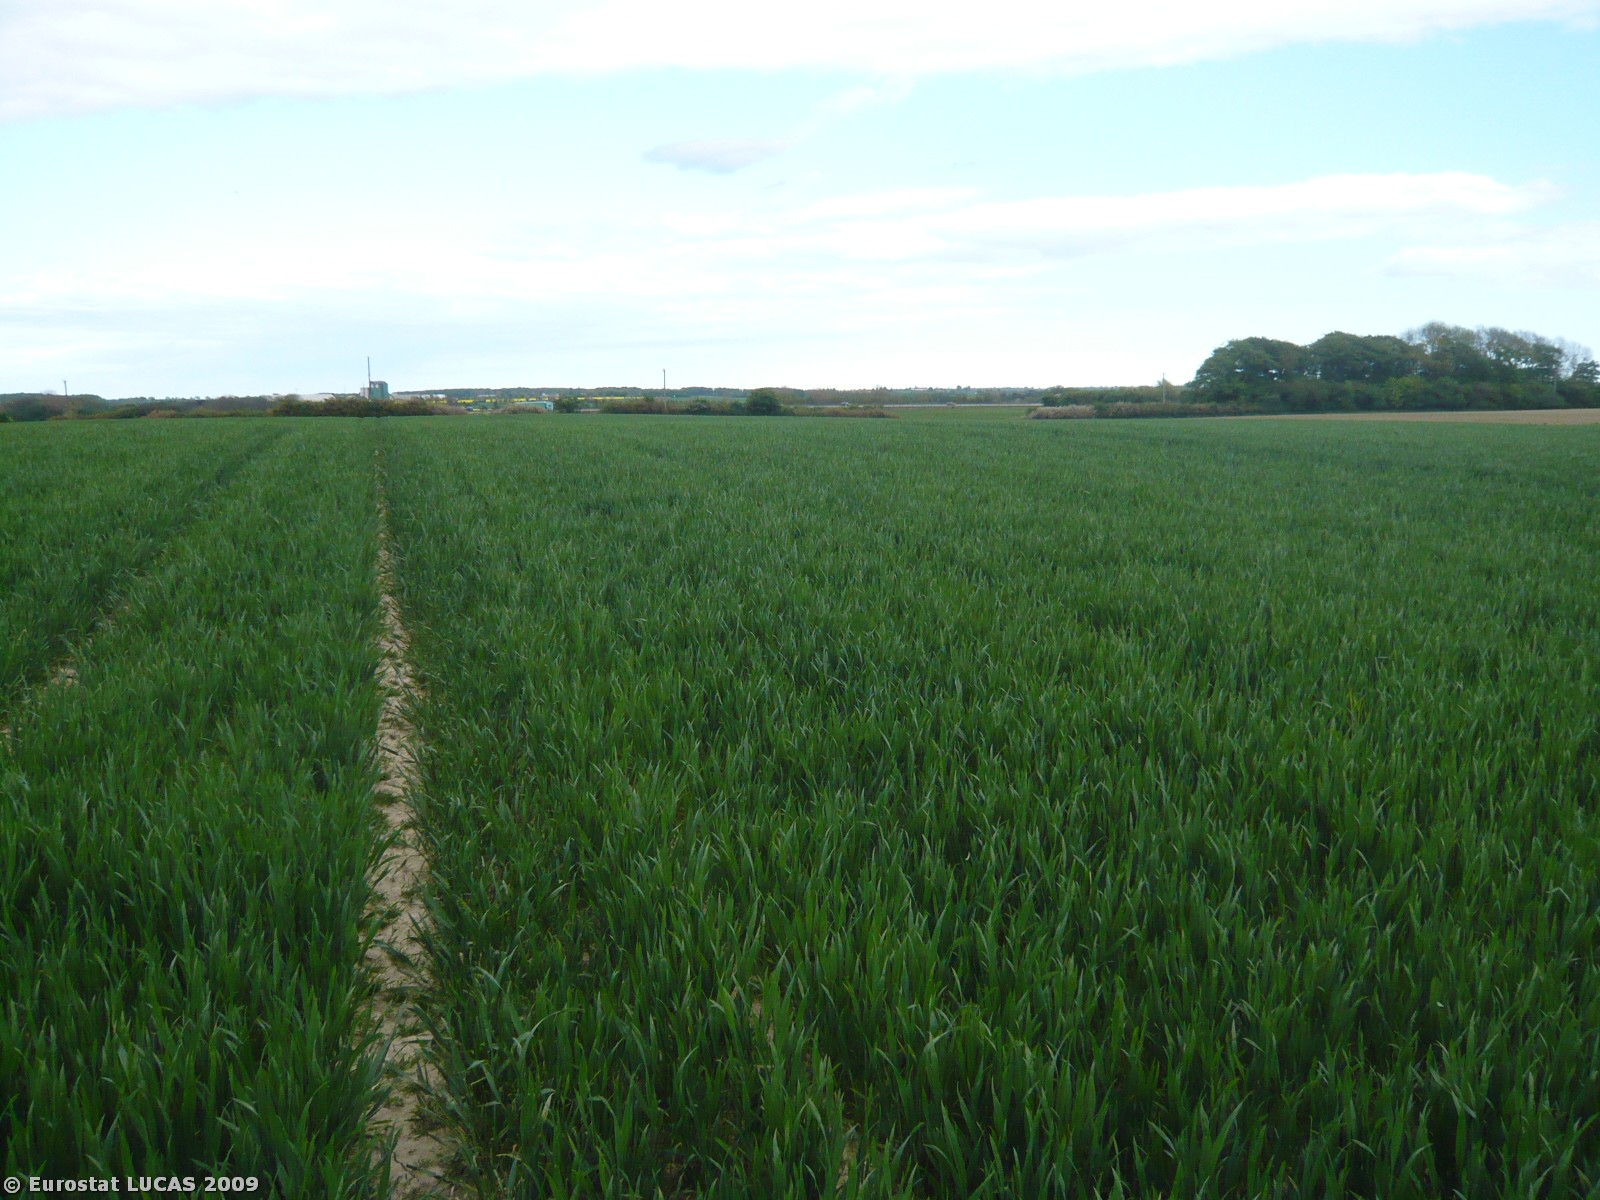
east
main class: Cropland
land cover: Common wheat
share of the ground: > 75 %
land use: Agriculture (excluding fallow land and kitchen gardens)
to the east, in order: Common wheat; Maize
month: May
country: DK
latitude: 55.1125
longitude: 11.9269
